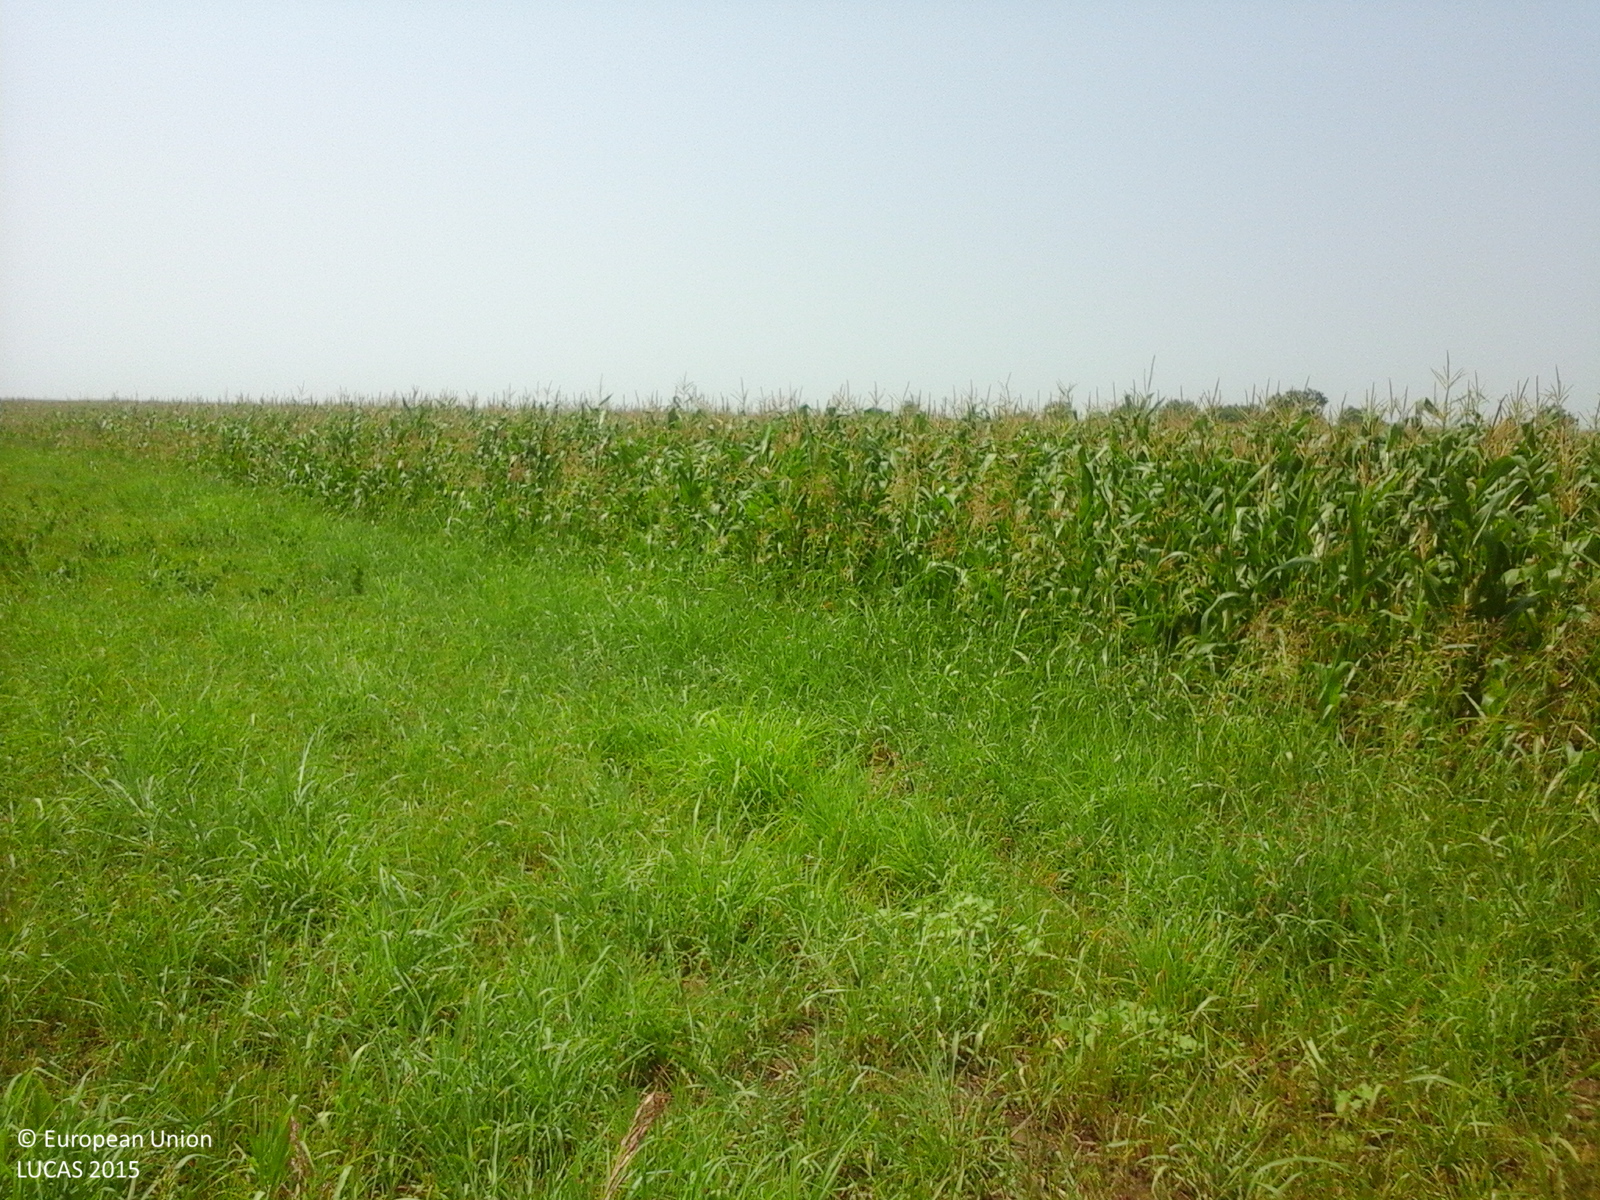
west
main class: Grassland
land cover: Grassland without tree/shrub cover
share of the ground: > 75 %
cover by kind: herbaceous plants 100 %
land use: Agriculture (excluding fallow land and kitchen gardens)
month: July
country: RO
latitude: 44.8530
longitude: 26.6357
